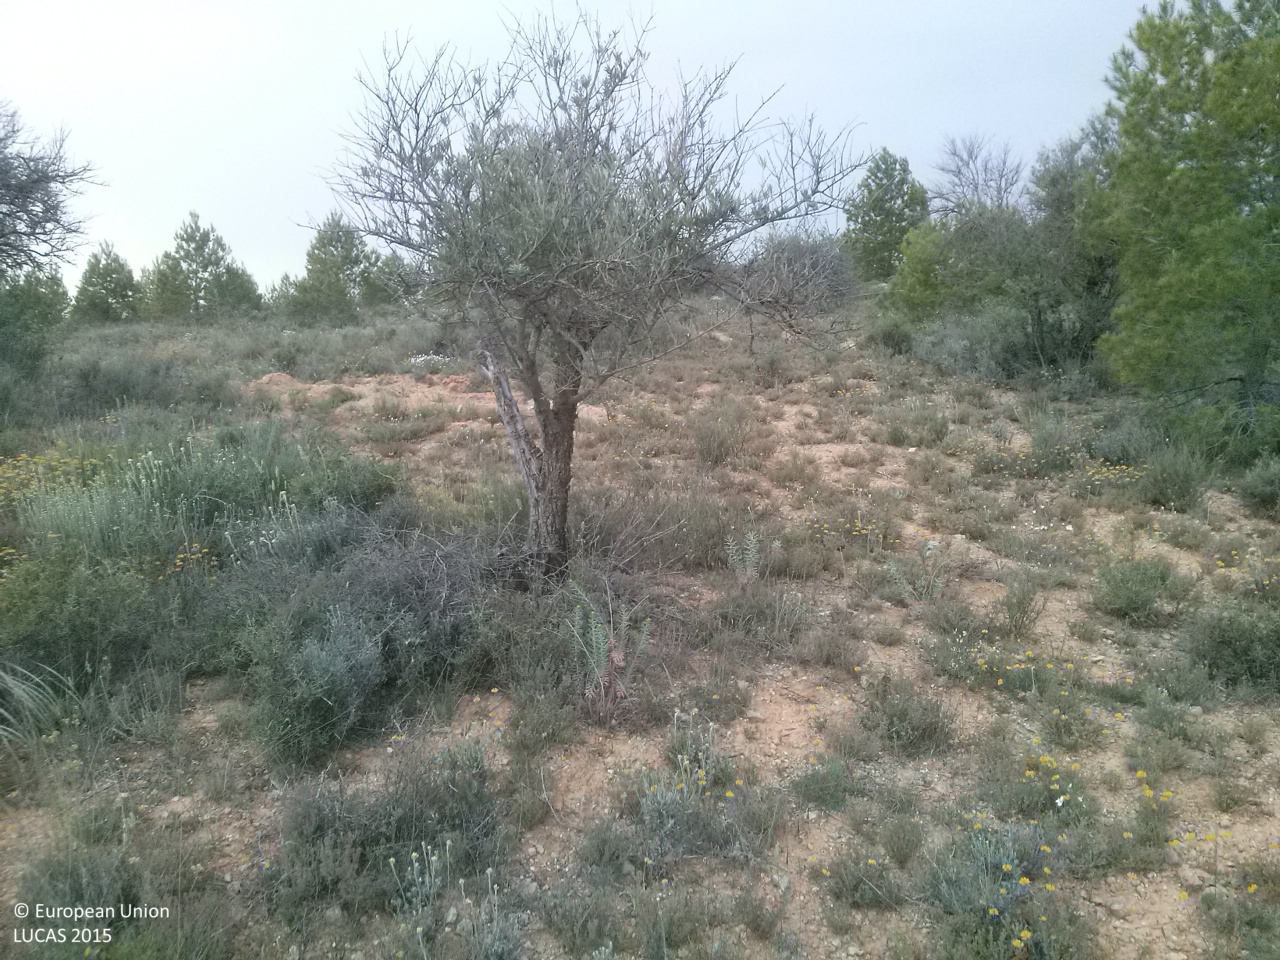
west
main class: Woodland
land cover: Pine dominated mixed woodland
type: coniferous forest of the mediterranean region
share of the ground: 10 - 25 %
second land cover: Shrubland without tree cover
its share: 50 - 75 %
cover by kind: shrubs 30 %, unconsolidated bare surface 25 %, herbaceous plants 20 %, coniferous forest trees 15 %, broadleaved forest trees 10 %
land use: Forestry
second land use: Agriculture (excluding fallow land and kitchen gardens)
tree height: > 5 m
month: May
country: ES
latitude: 39.9802
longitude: -2.8913
